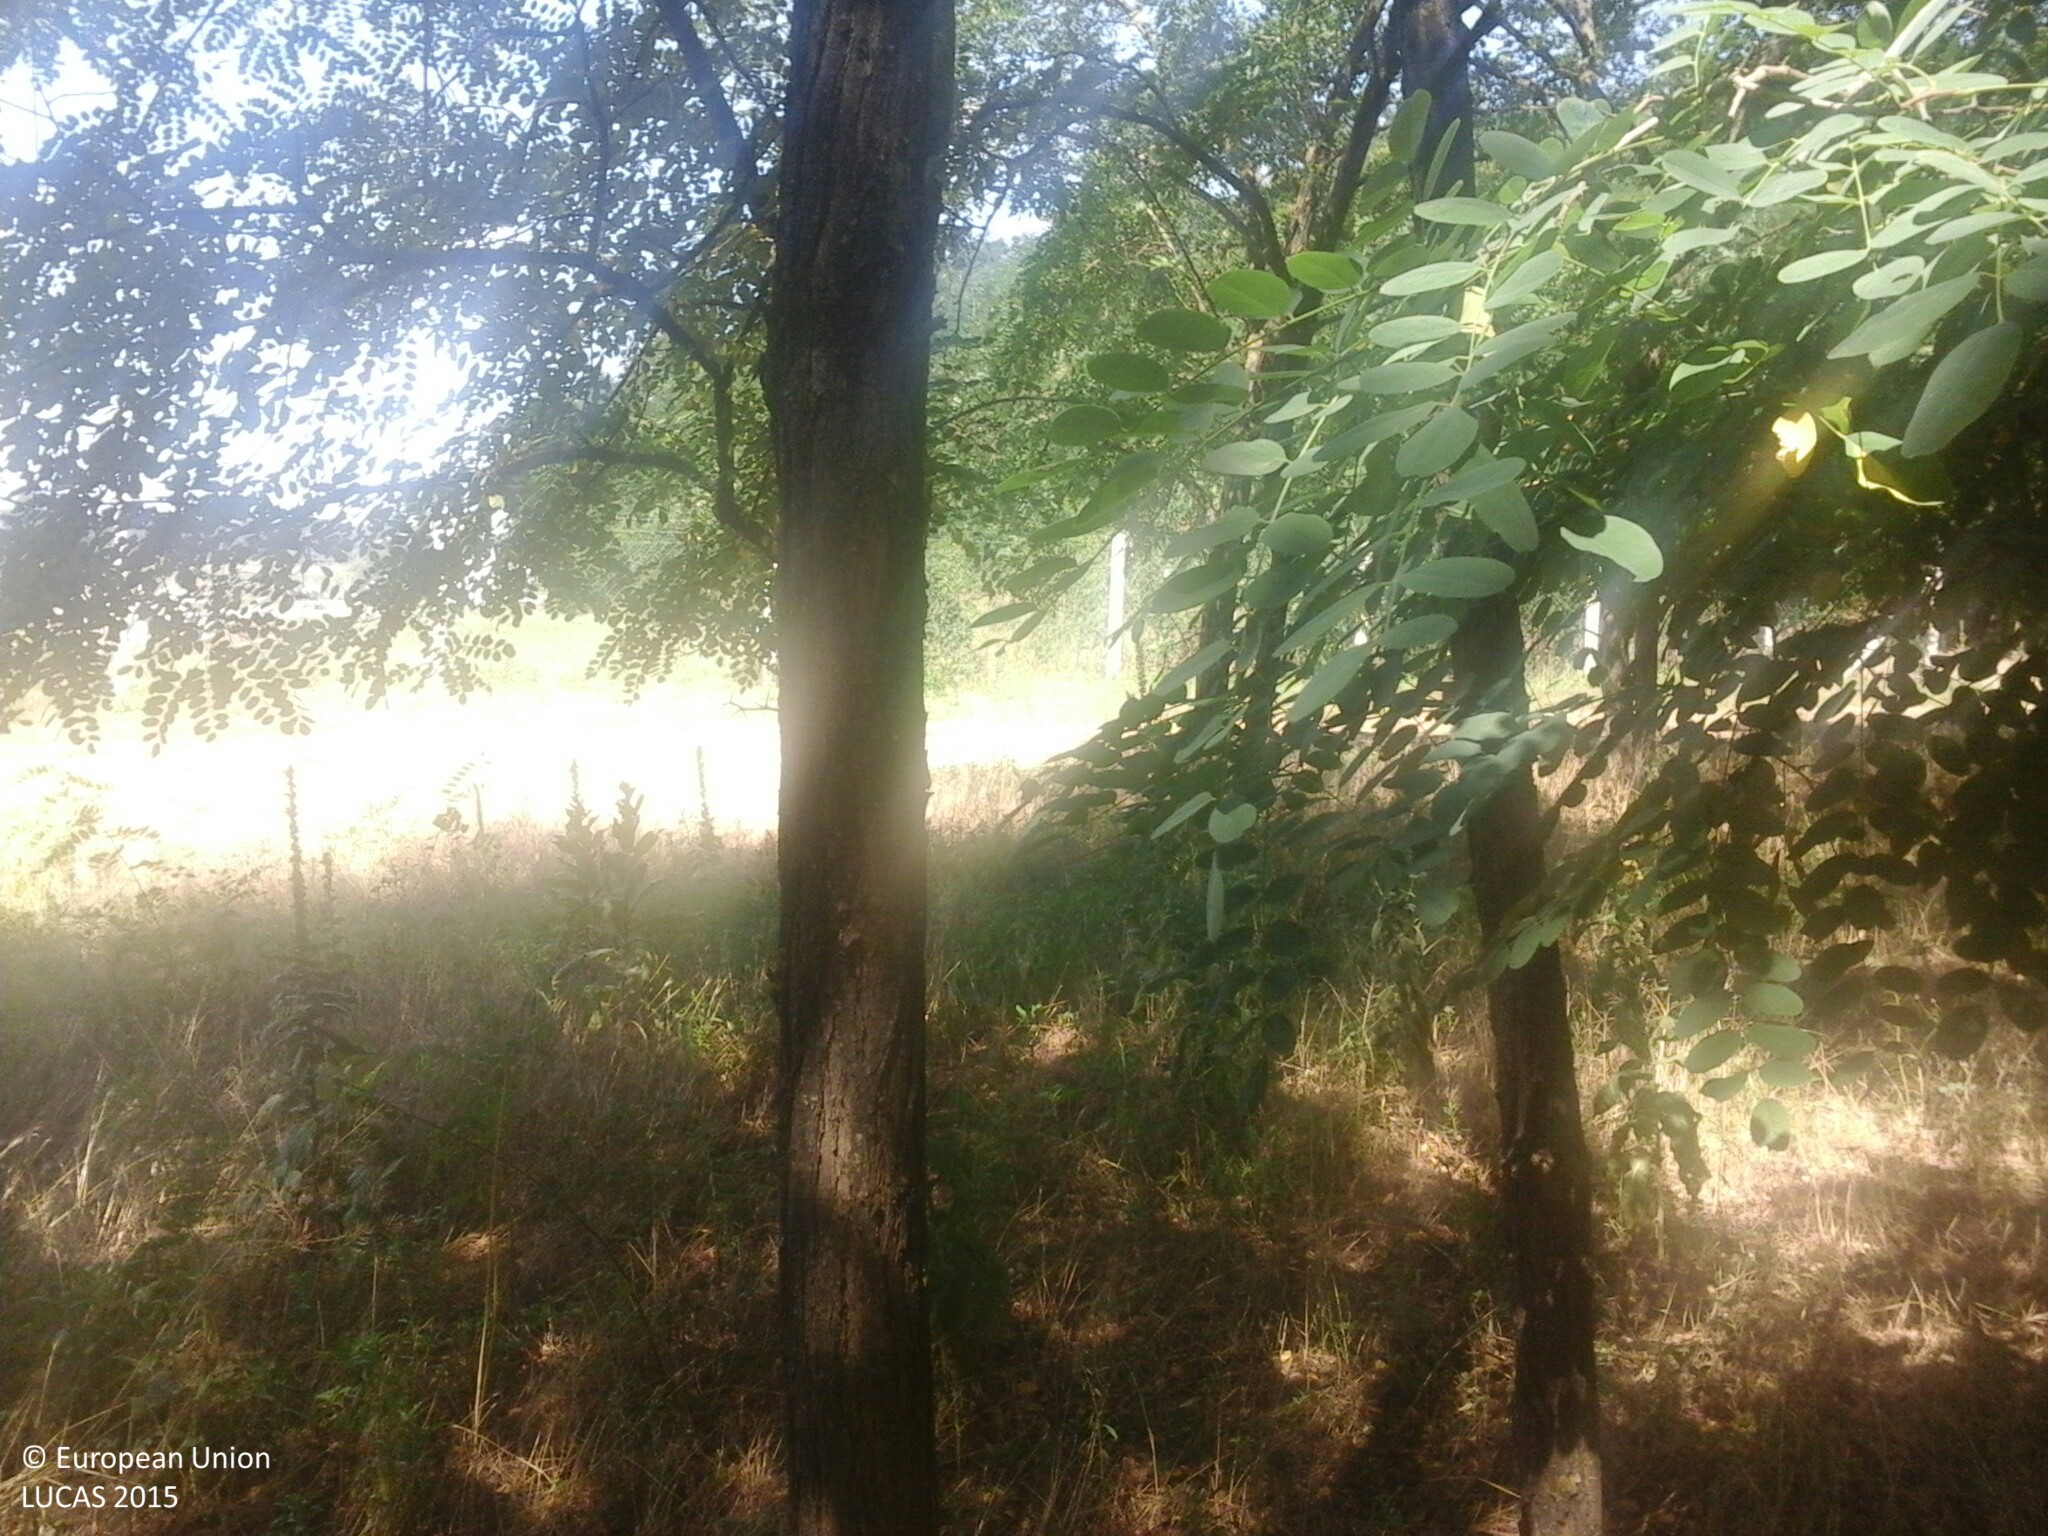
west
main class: Woodland
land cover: Broadleaved woodland
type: exotic forest
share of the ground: > 75 %
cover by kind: broadleaved forest trees 95 %, herbaceous plants 5 %
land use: Forestry
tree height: > 5 m
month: July
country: HU
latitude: 48.0409
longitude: 22.3029
